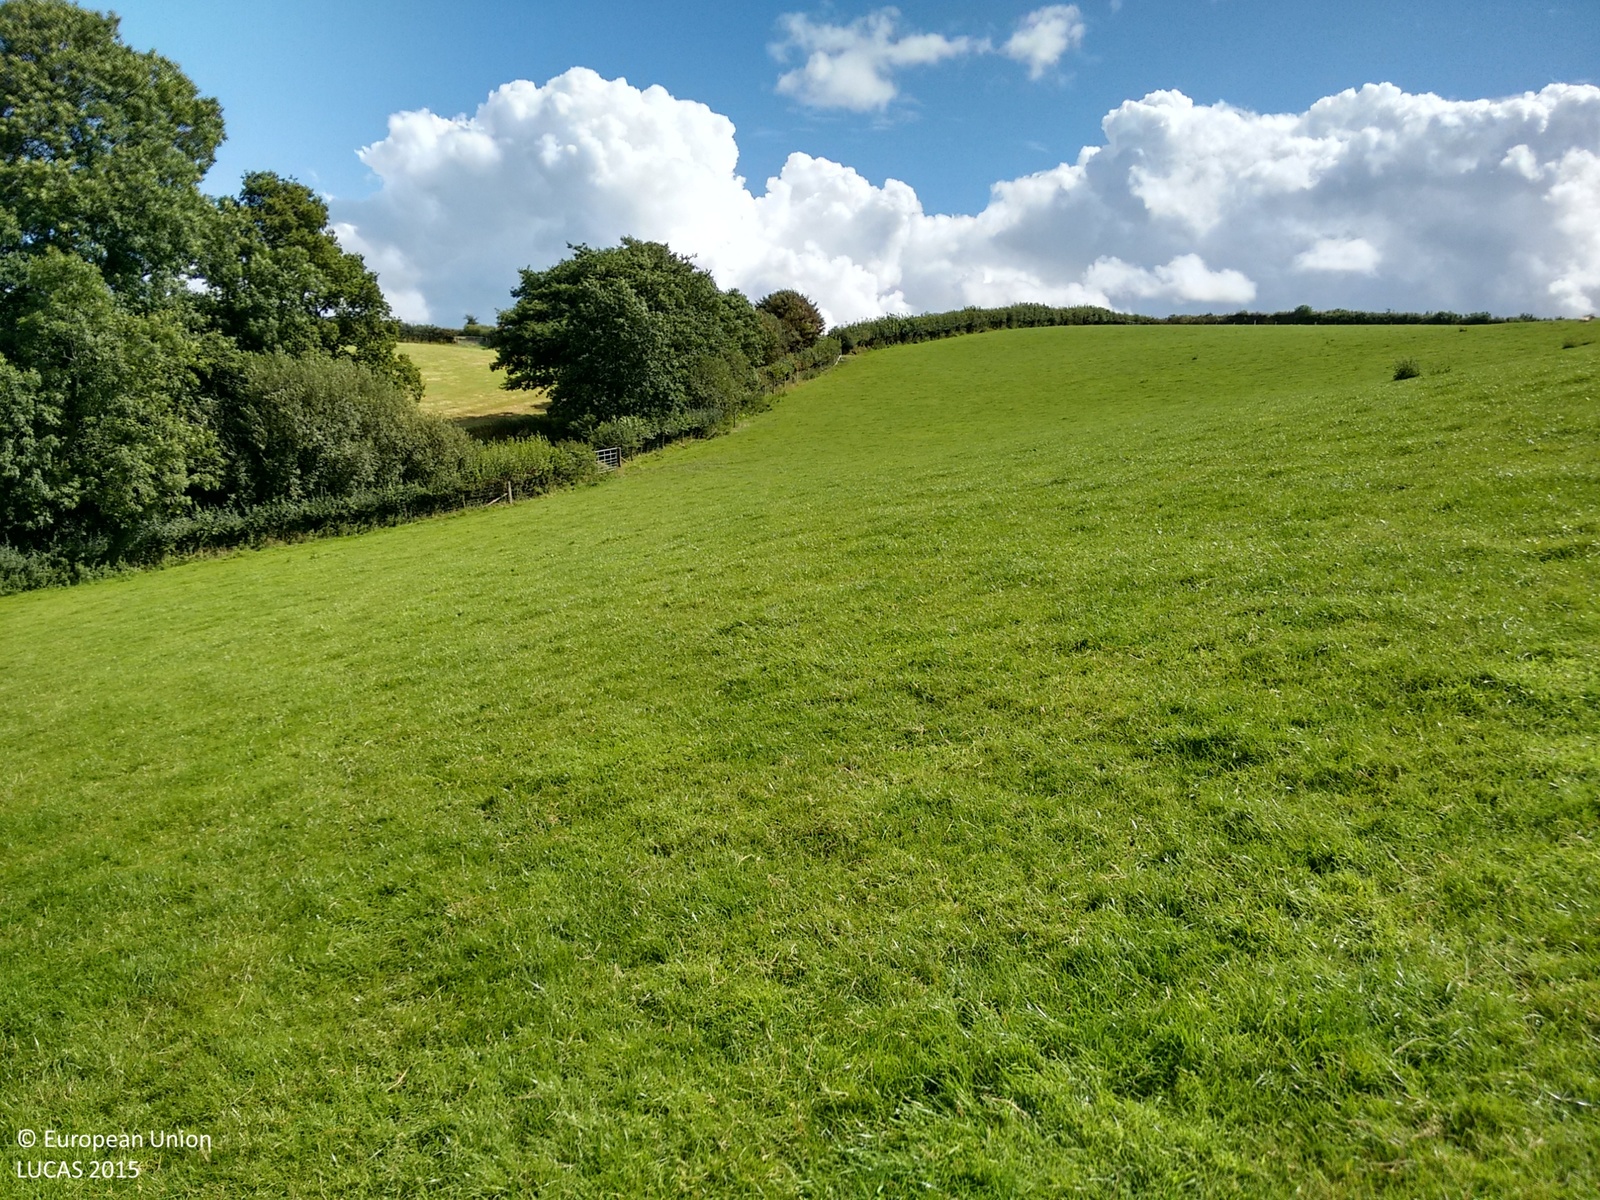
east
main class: Grassland
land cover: Grassland without tree/shrub cover
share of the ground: > 75 %
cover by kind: herbaceous plants 100 %
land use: Agriculture (excluding fallow land and kitchen gardens)
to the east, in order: Grassland without tree/shrub cover; Fences; Managed hedges; Broadleaved woodland; Grass margins; Tracks; Grassland without tree/shrub cover; Tracks; Ditches and canals; Managed hedges; Grass margins; Barley
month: August
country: GB
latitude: 50.9814
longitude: -3.8072
